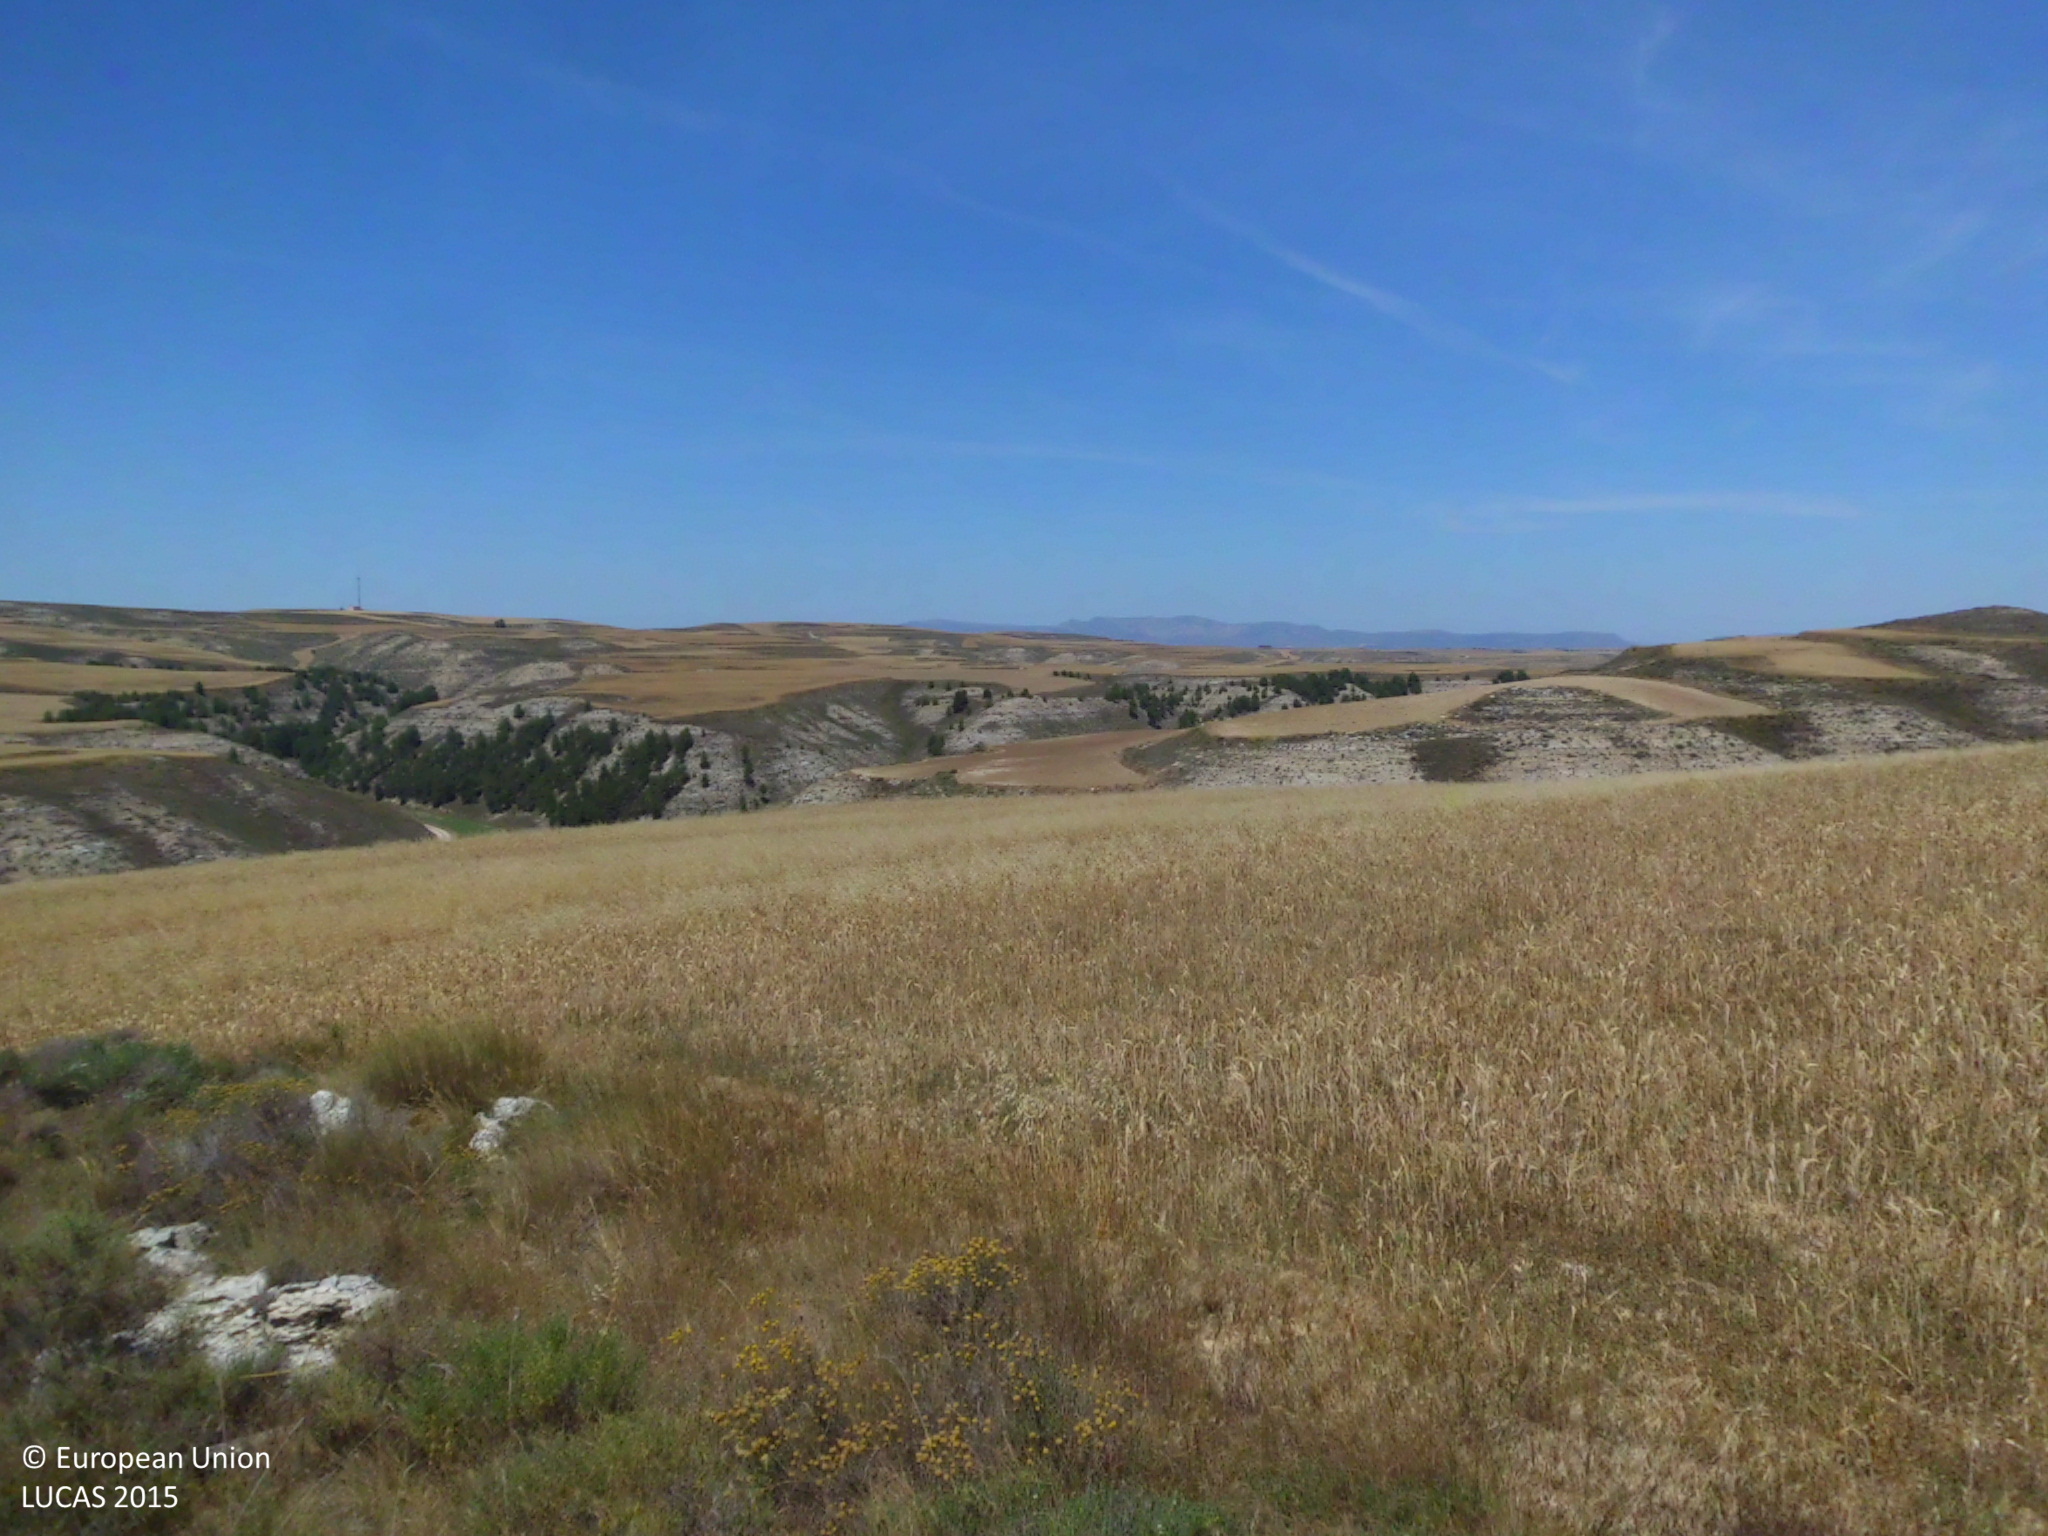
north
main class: Shrubland
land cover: Shrubland without tree cover
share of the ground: 50 - 75 %
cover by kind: shrubs 50 %, unconsolidated bare surface 35 %, herbaceous plants 15 %
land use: Semi-natural and natural areas not in use
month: July
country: ES
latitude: 42.4848
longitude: -3.3045
